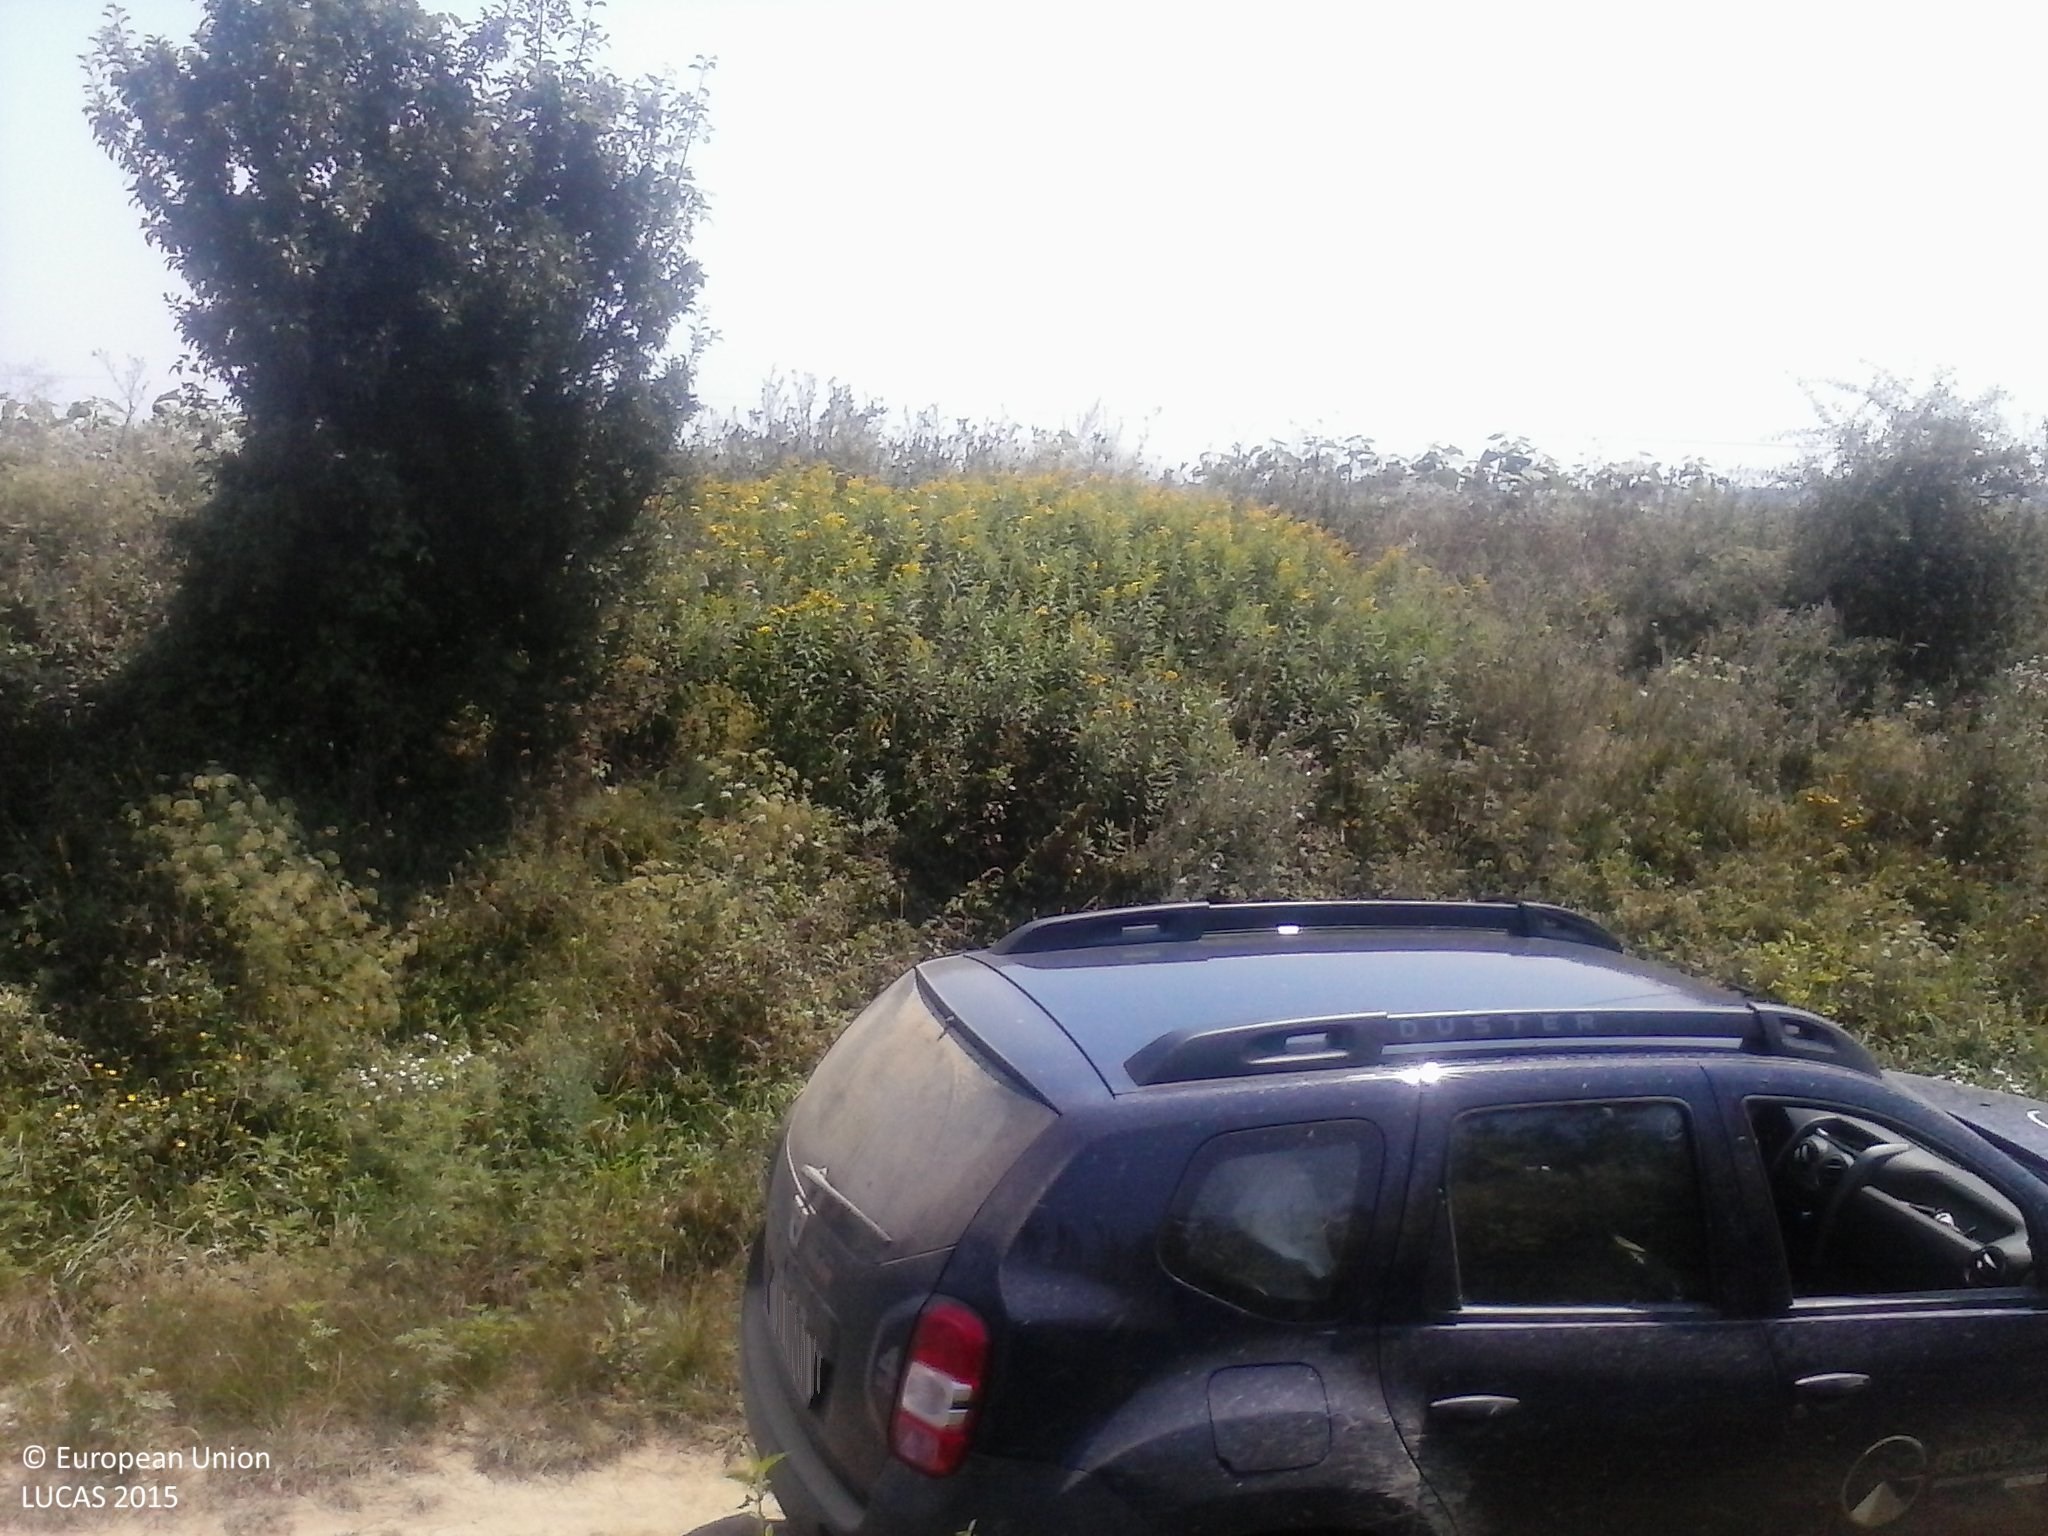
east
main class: Cropland
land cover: Maize
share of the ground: > 75 %
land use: Agriculture (excluding fallow land and kitchen gardens)
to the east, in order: Maize; Fences; Abandoned hedges; Tracks; Abandoned hedges; Spontaneously vegetated surfaces; Fences; Sunflower
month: August
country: HU
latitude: 46.1697
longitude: 17.8675
